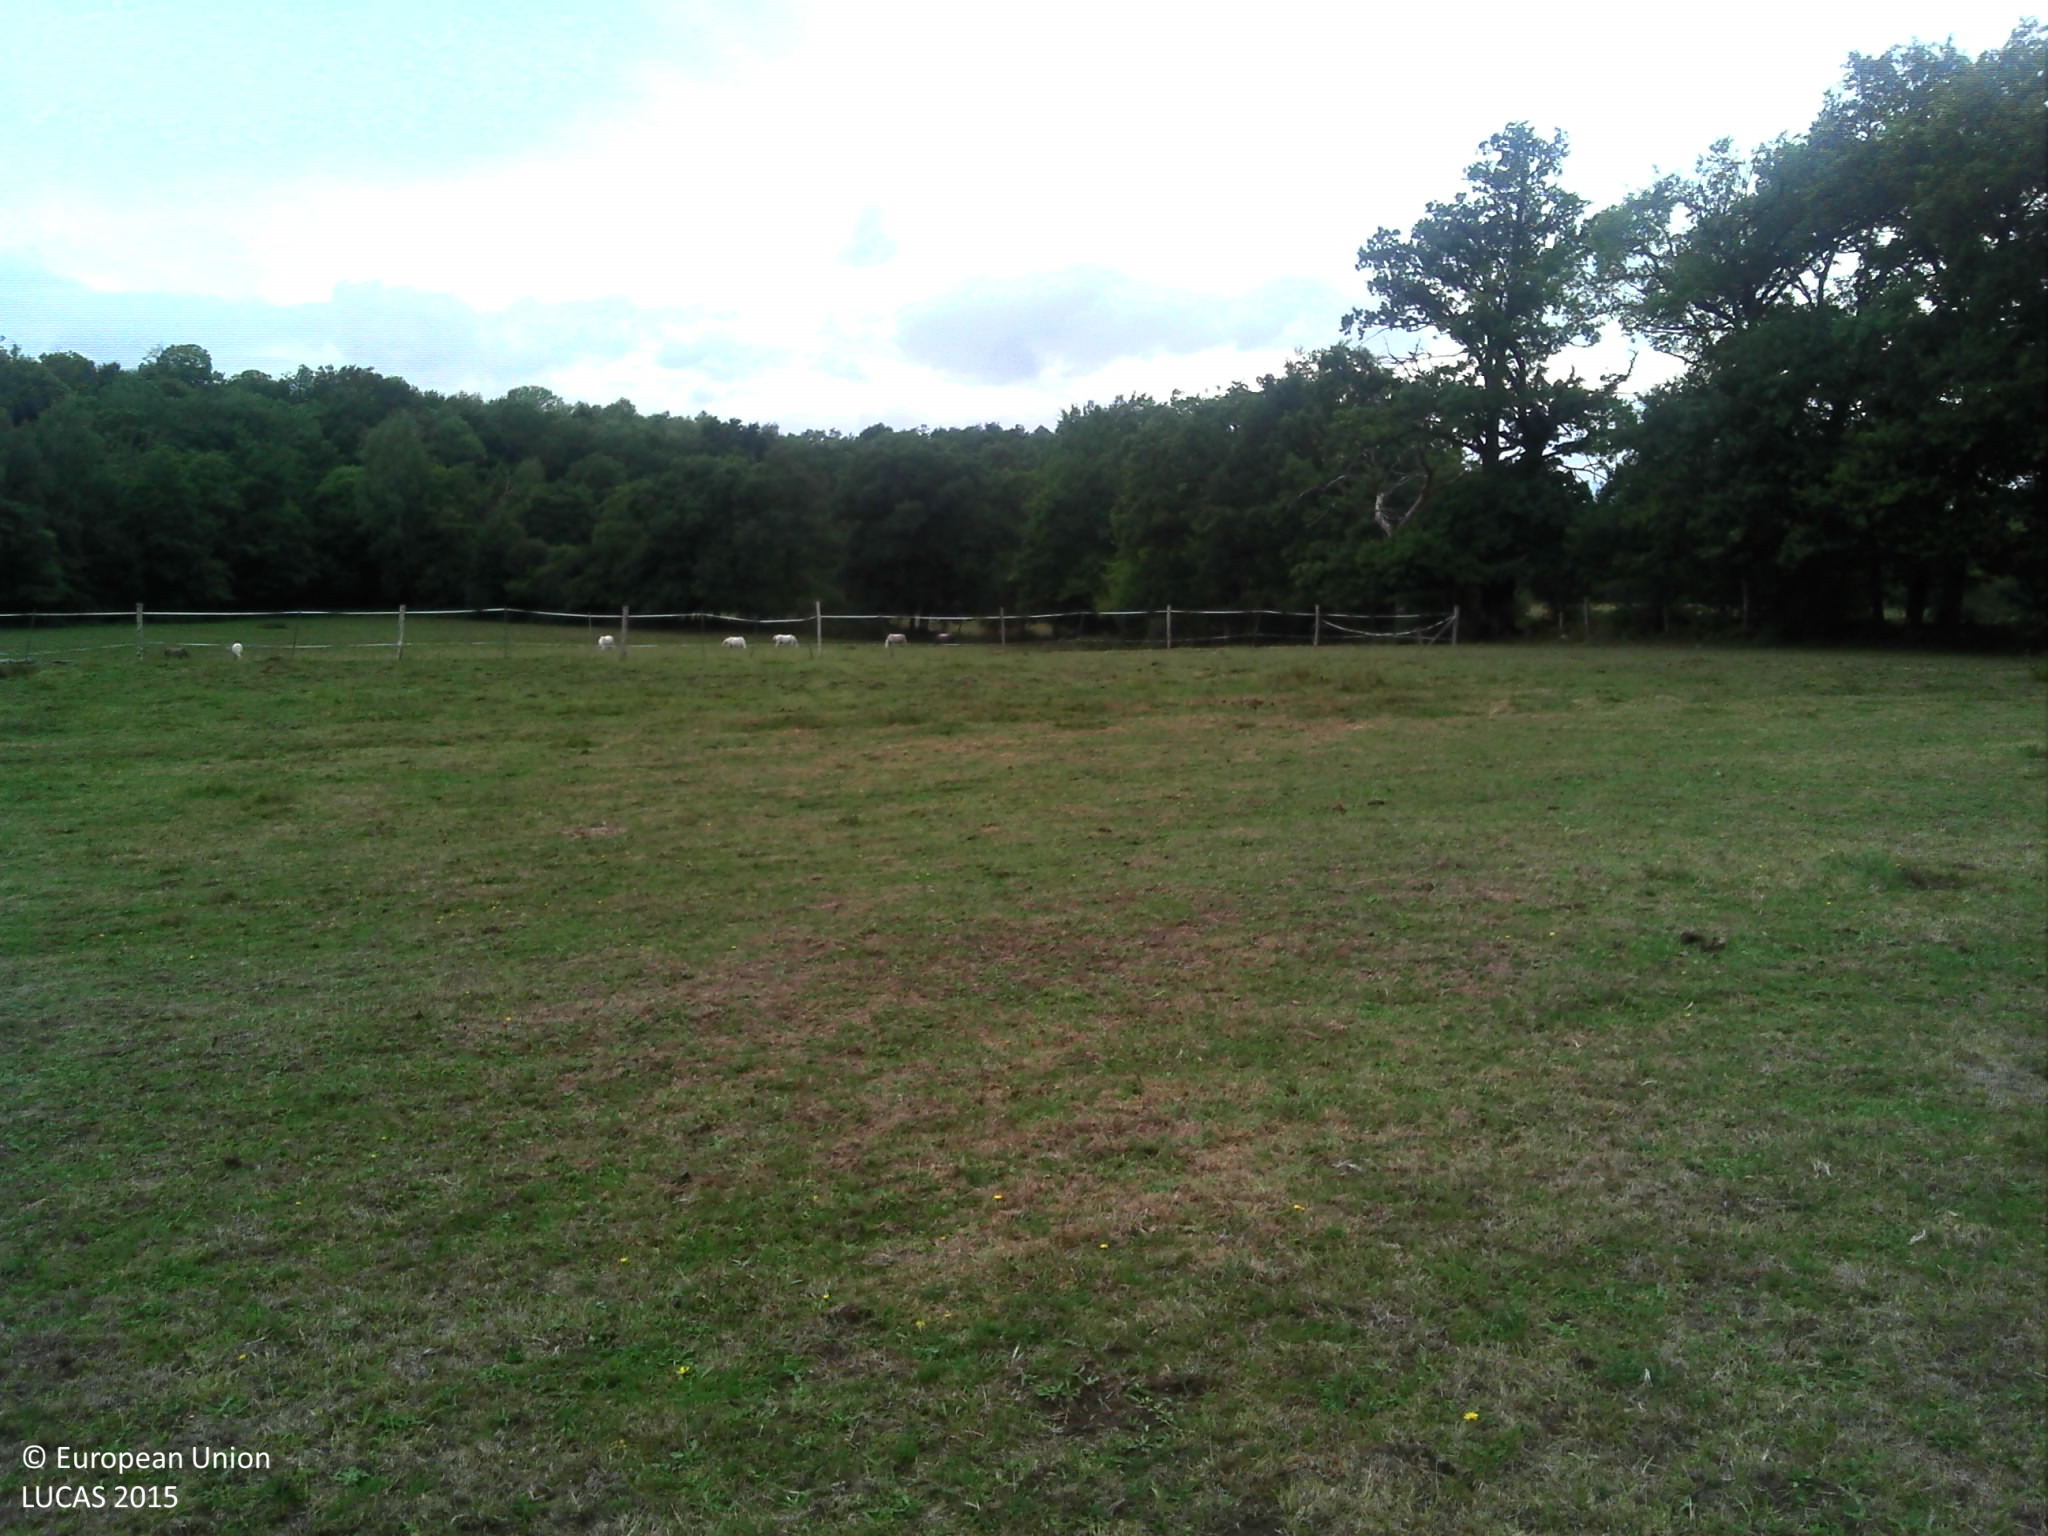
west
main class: Grassland
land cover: Grassland without tree/shrub cover
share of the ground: > 75 %
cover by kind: herbaceous plants 100 %
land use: Agriculture (excluding fallow land and kitchen gardens)
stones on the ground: 10 - 25 %
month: August
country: FR
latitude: 46.0421
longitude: 0.9813
